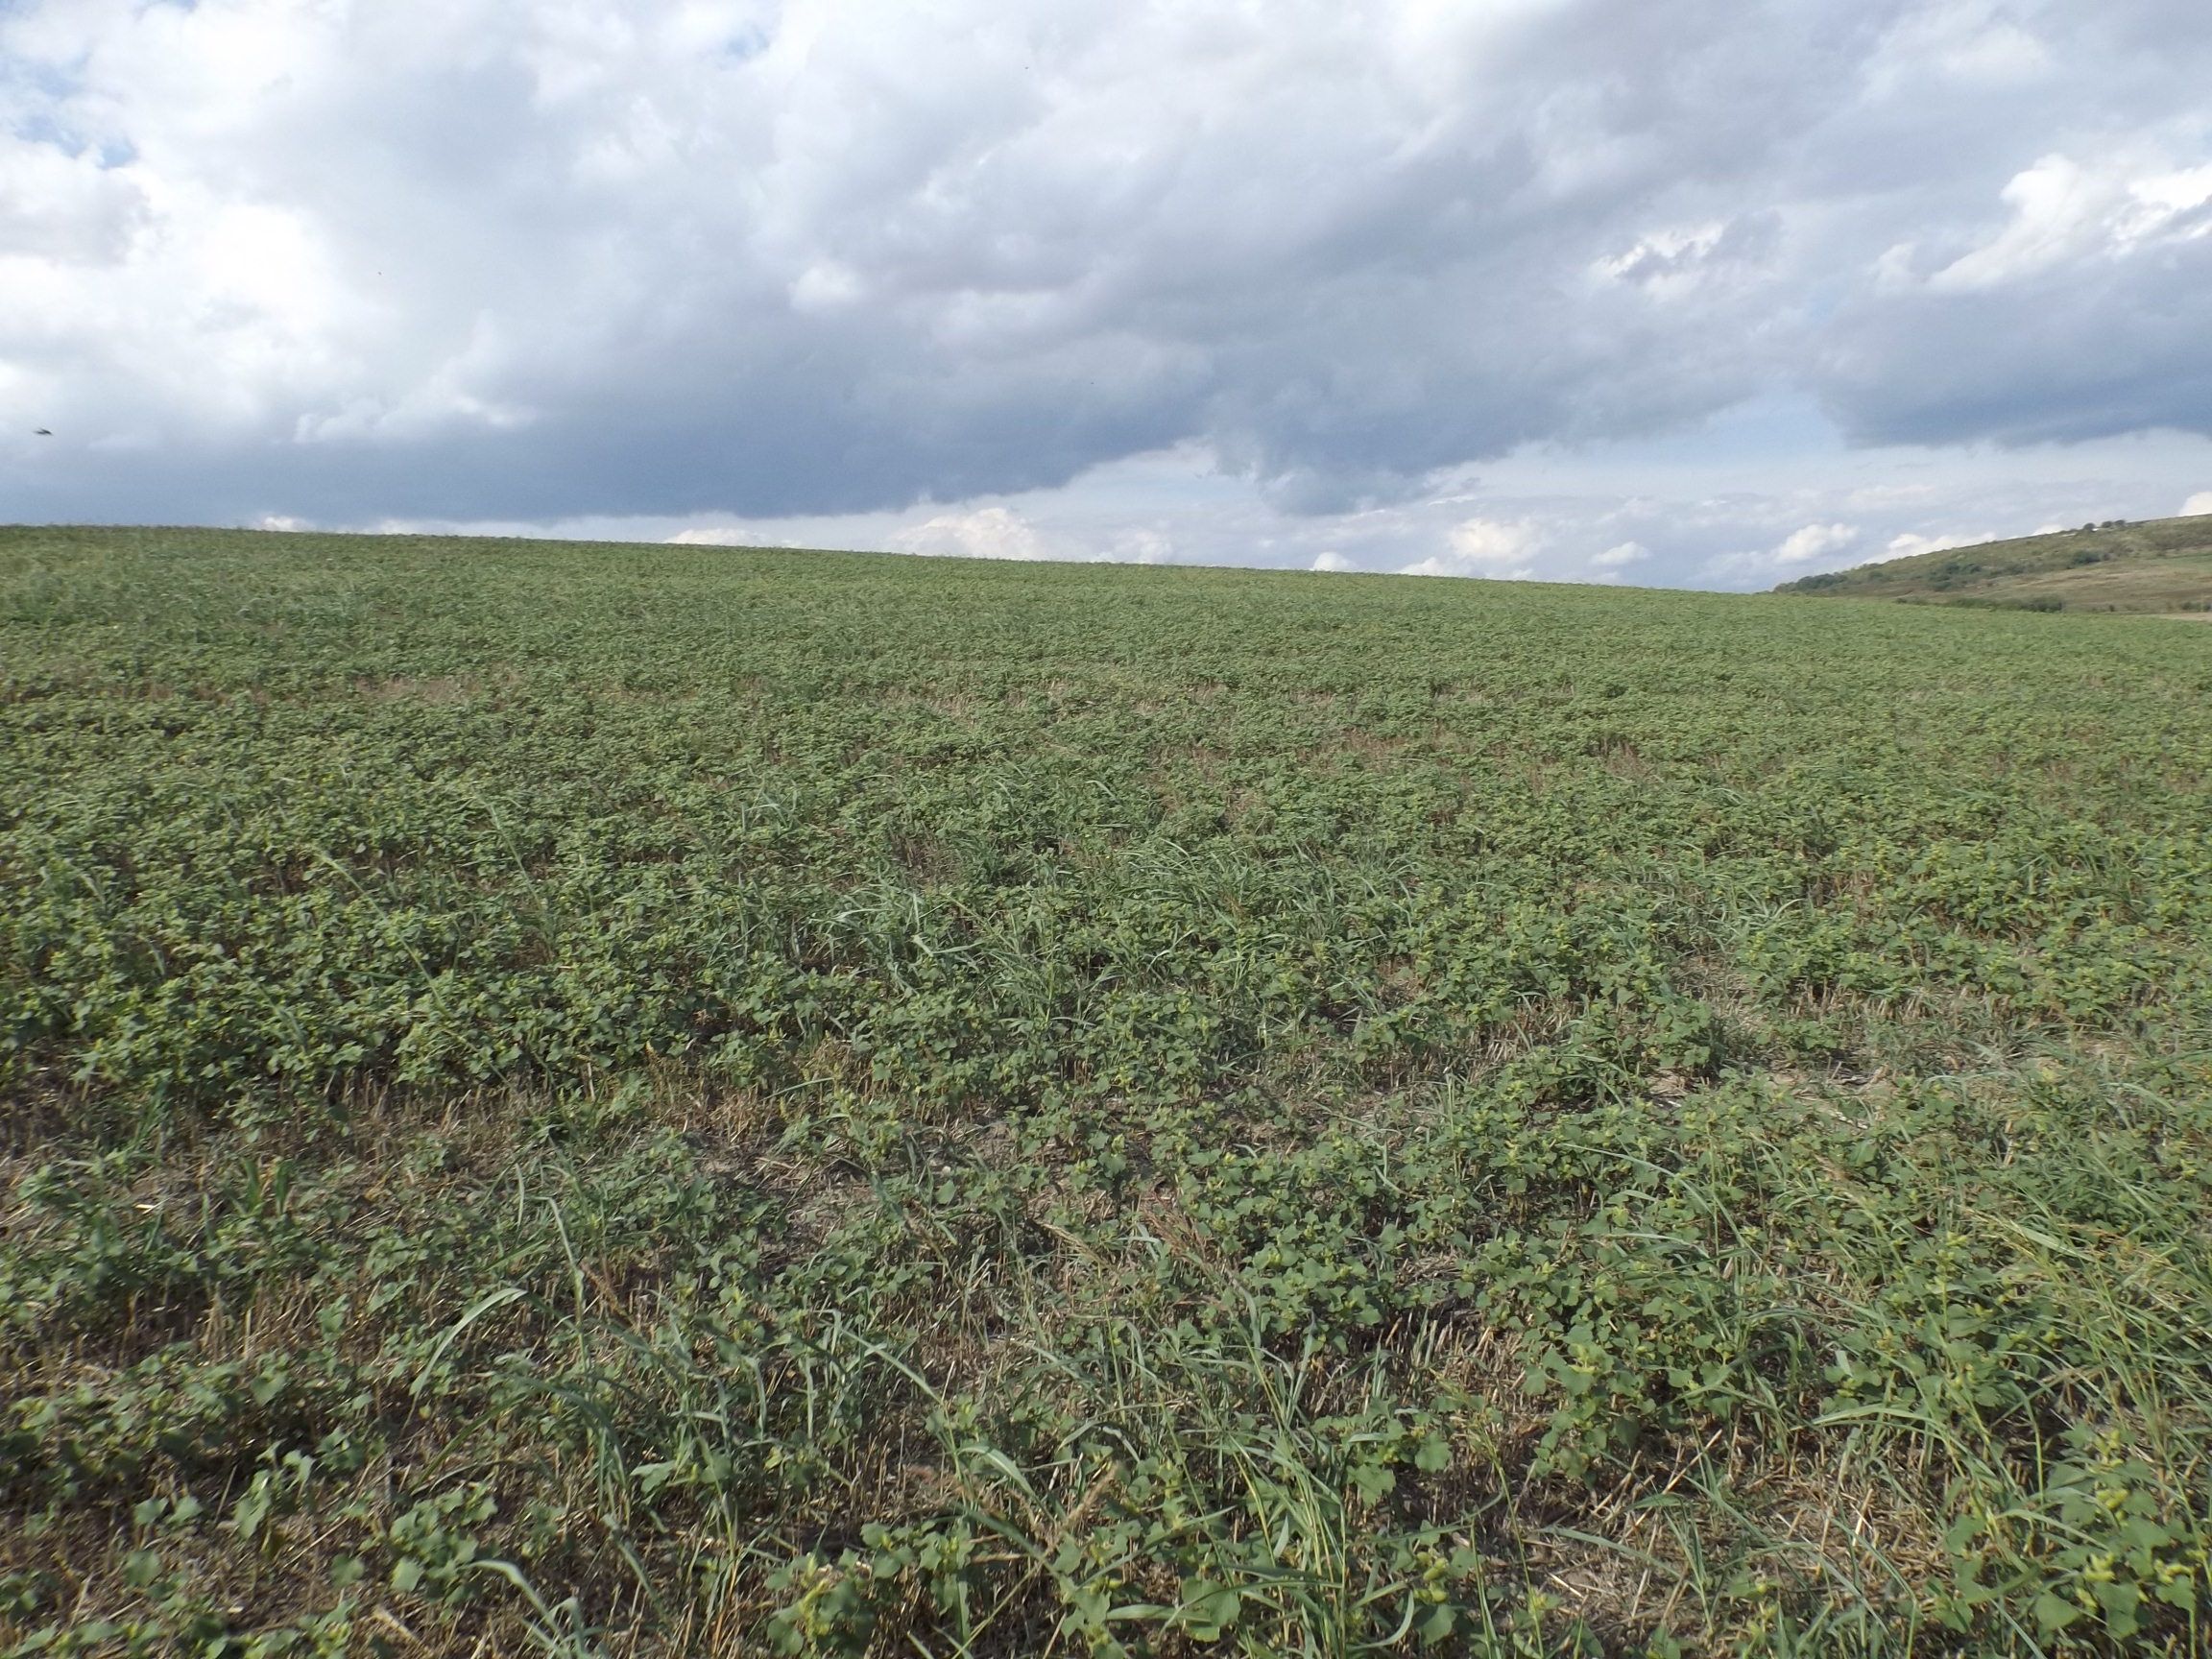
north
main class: Cropland
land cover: Common wheat
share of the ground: < 10 %
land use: Agriculture (excluding fallow land and kitchen gardens)
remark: Harvested field
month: September
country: BG
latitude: 43.2698
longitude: 27.4117
